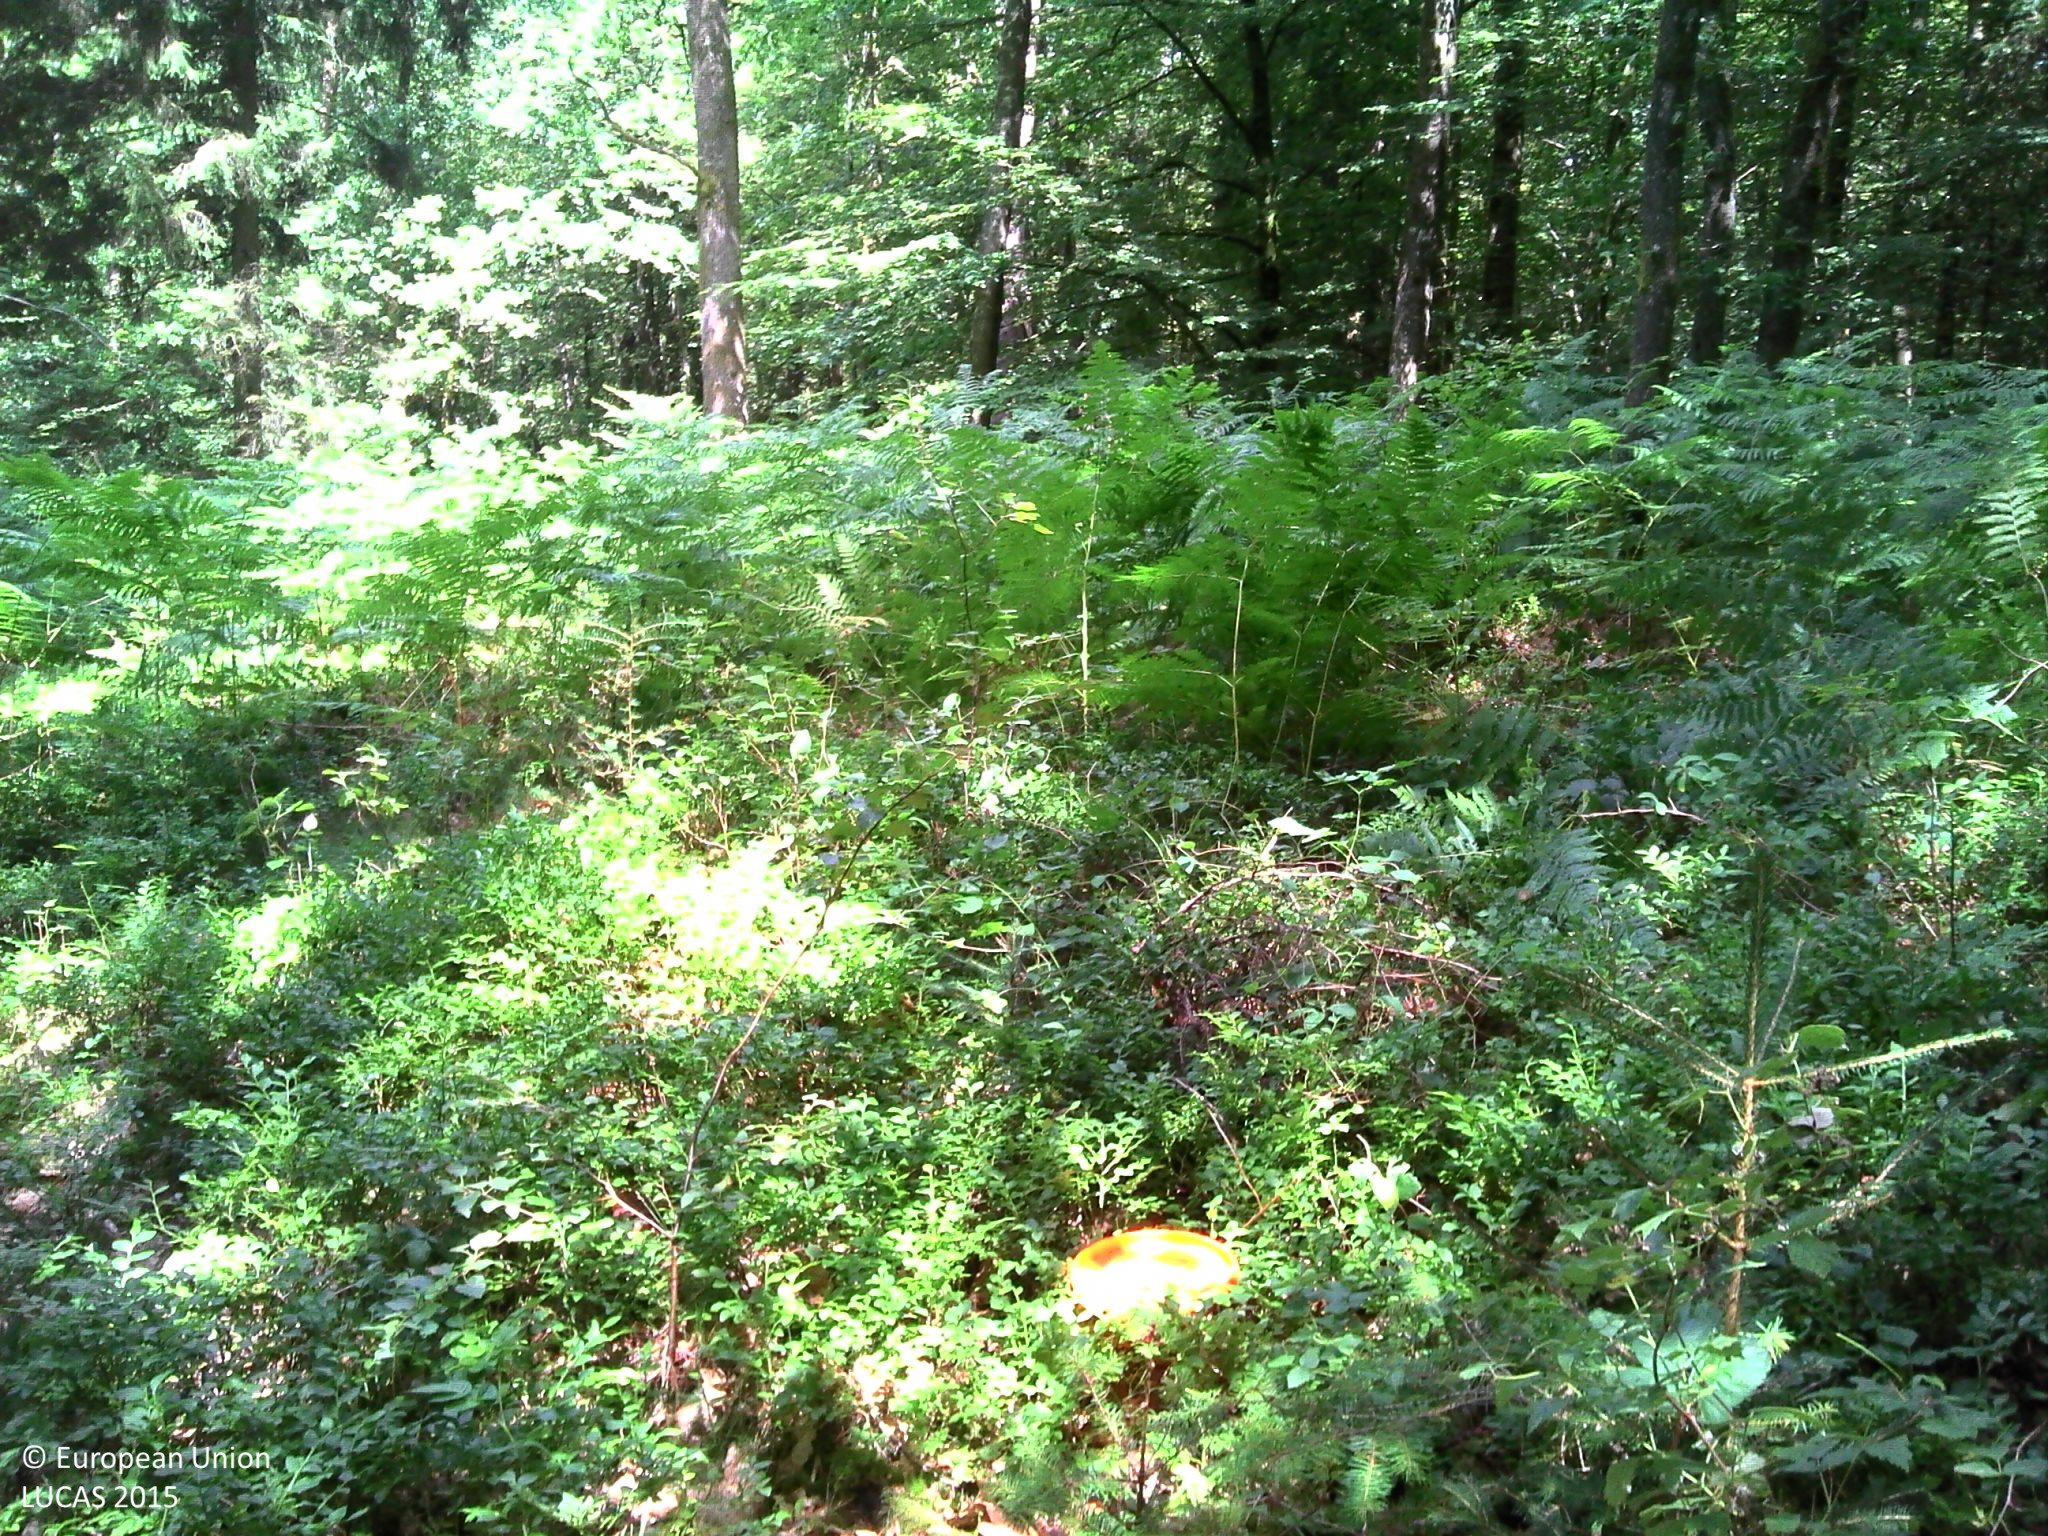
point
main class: Woodland
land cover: Broadleaved woodland
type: acidophilous oak and oak-birch forest
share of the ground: > 75 %
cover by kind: broadleaved forest trees 70 %, herbaceous plants 20 %, coniferous forest trees 10 %
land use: Forestry
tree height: > 5 m
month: July
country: BE
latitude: 49.6336
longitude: 5.6650
